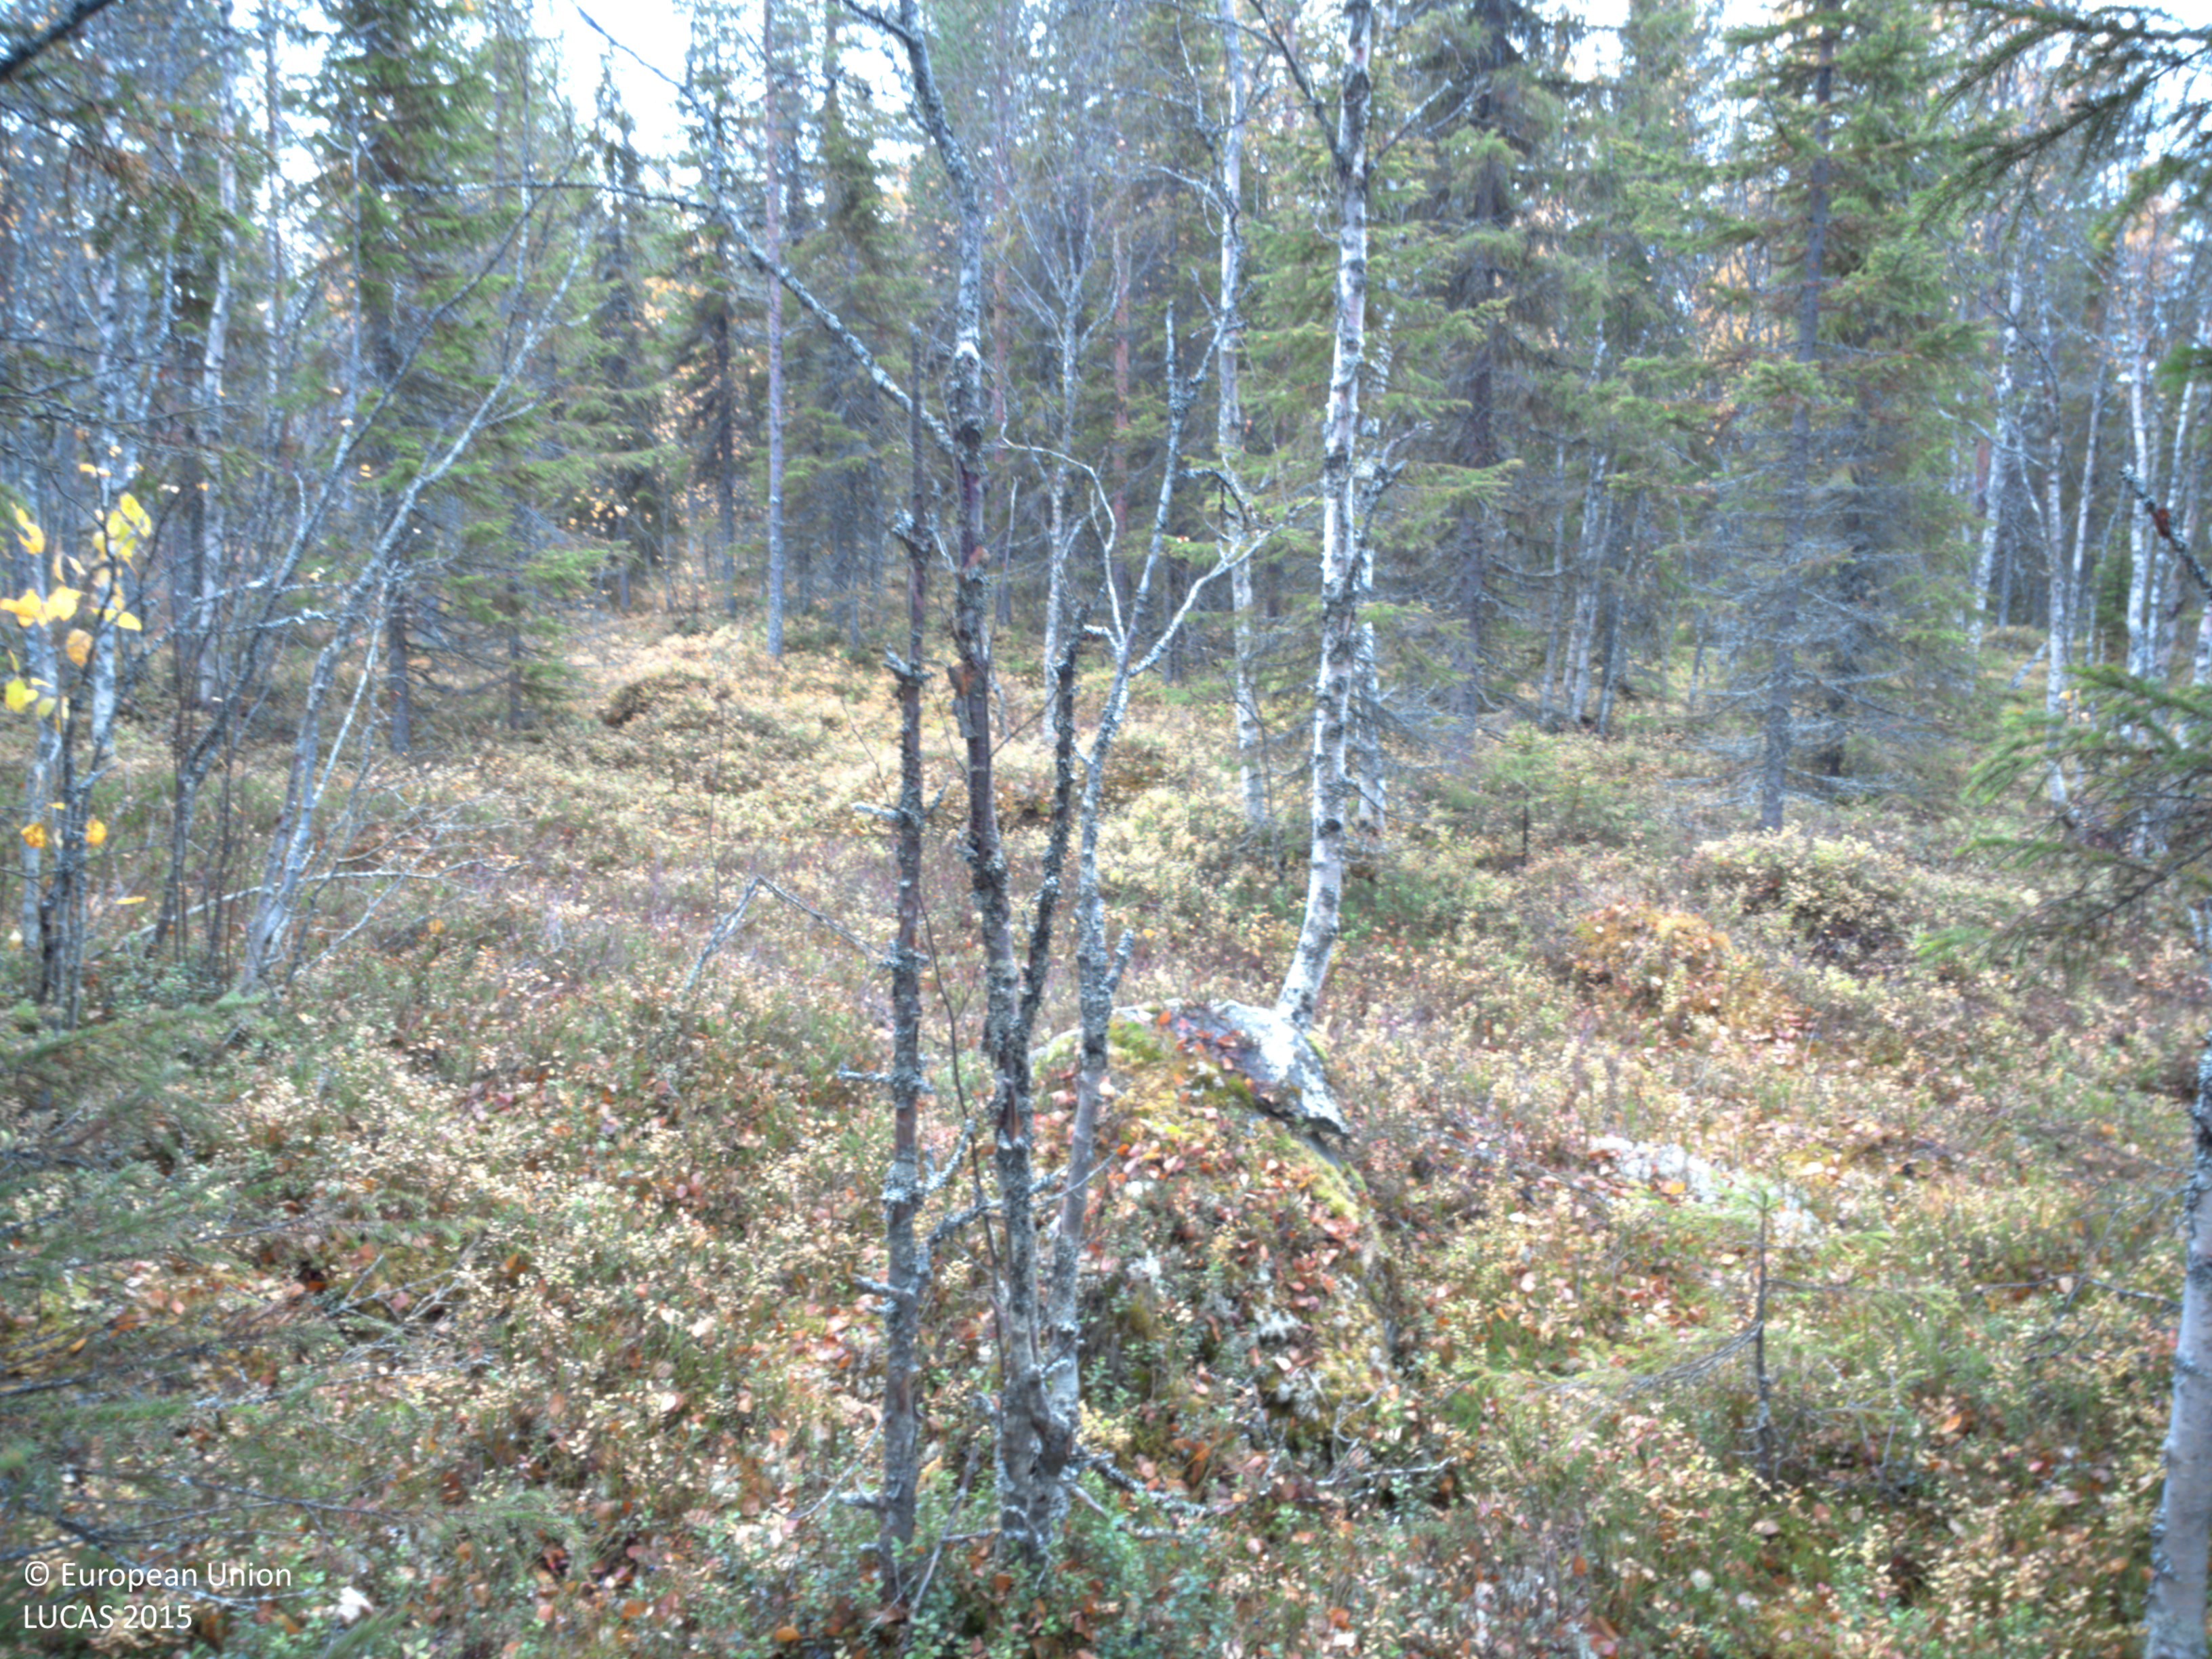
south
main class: Woodland
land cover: Other coniferous woodland
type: boreal forest
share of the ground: 50 - 75 %
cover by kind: coniferous forest trees 65 %, shrubs 20 %, broadleaved forest trees 5 %, herbaceous plants 5 %, lichens and mosses 5 %
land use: Forestry
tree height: > 5 m
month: October
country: SE
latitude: 64.9819
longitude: 17.9109
